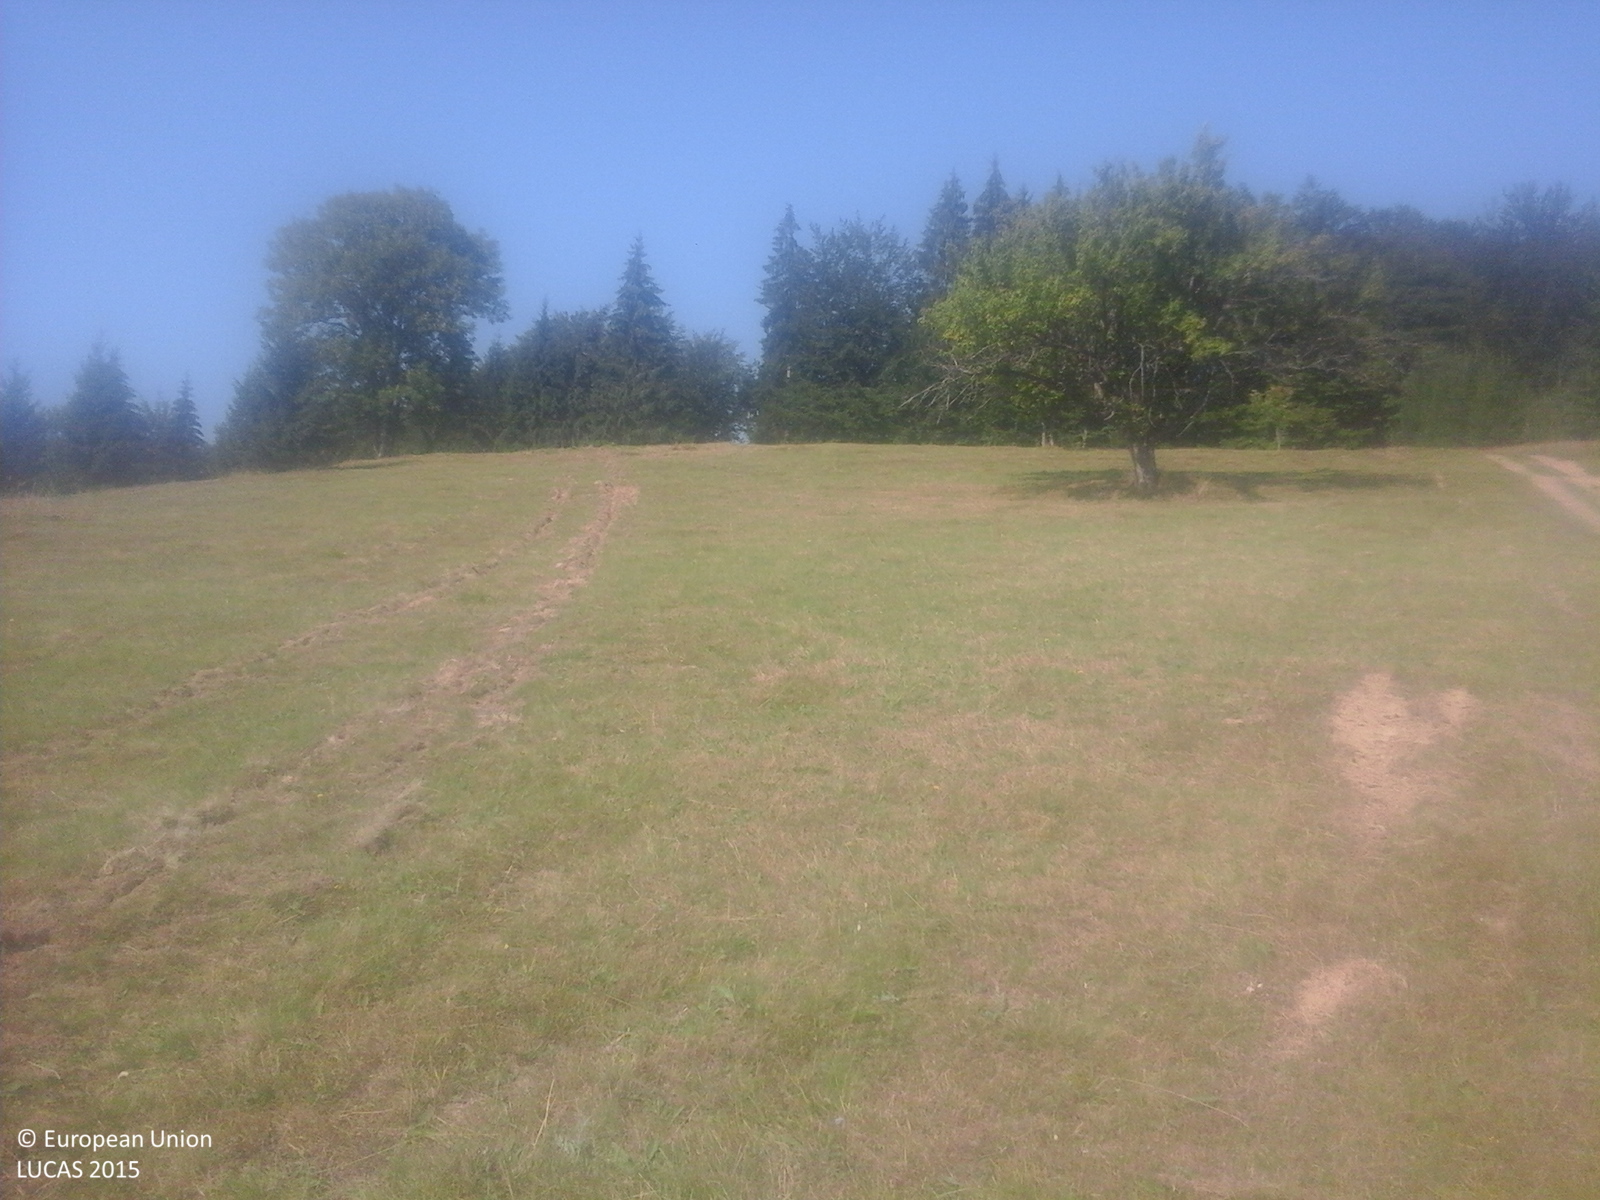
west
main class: Grassland
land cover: Grassland without tree/shrub cover
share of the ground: > 75 %
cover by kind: herbaceous plants 100 %
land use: Agriculture (excluding fallow land and kitchen gardens)
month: September
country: RO
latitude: 47.5845
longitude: 24.3853
